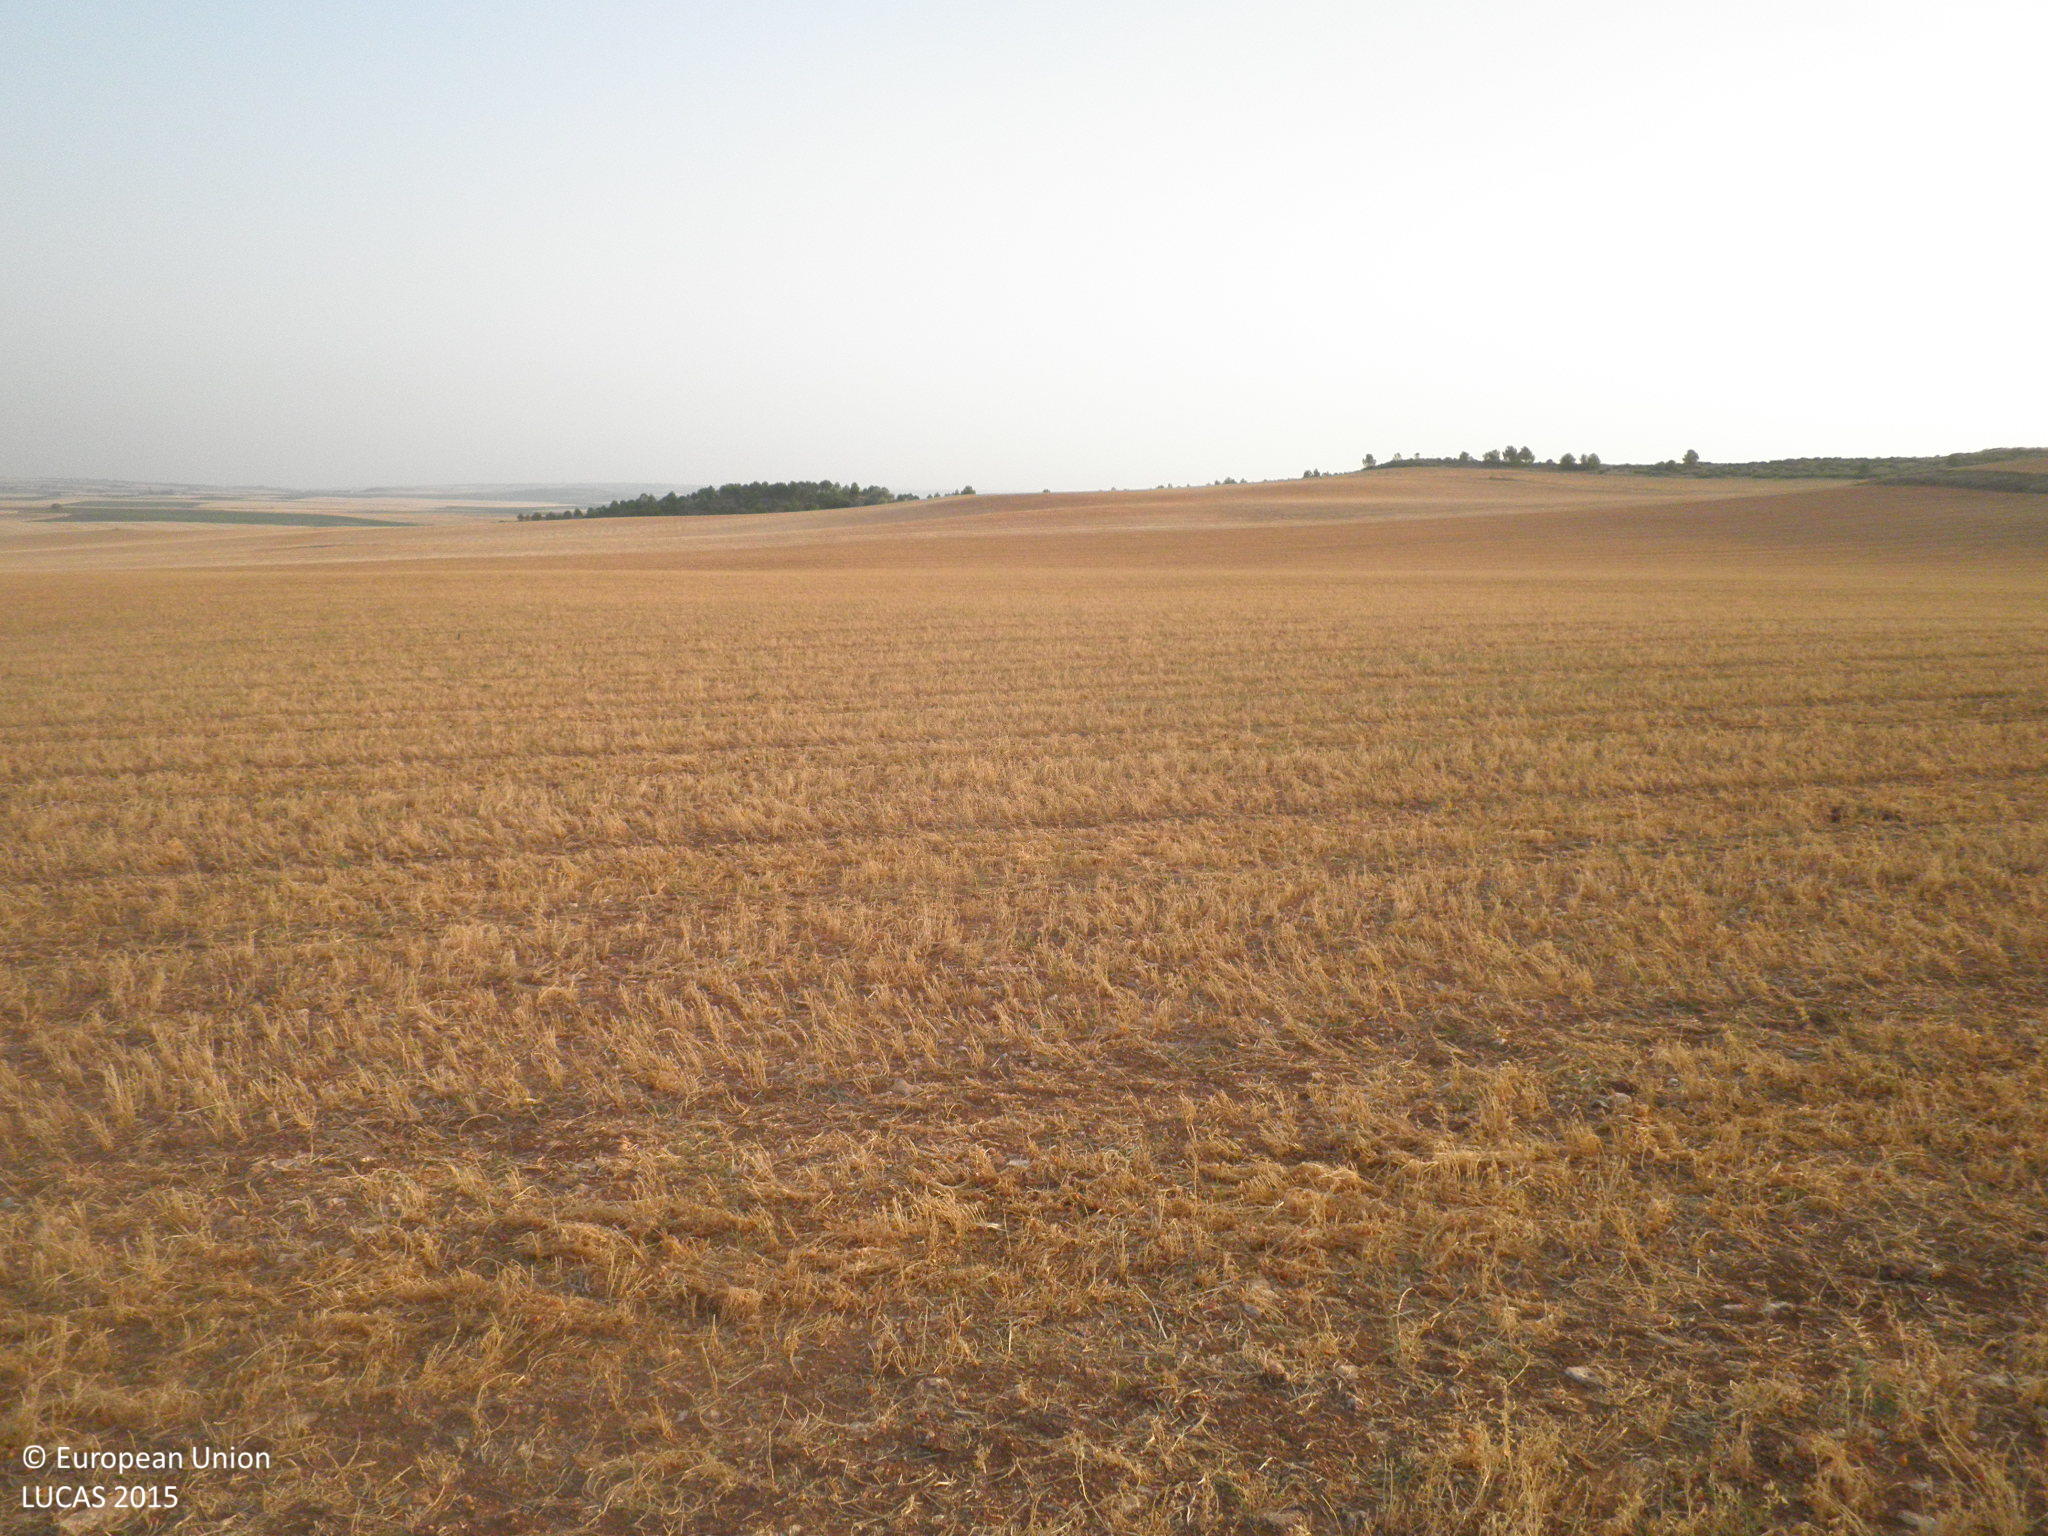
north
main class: Cropland
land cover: Dry pulses
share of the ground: 25 - 50 %
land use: Agriculture (excluding fallow land and kitchen gardens)
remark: Harvested field
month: July
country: ES
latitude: 39.5261
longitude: -2.4480
